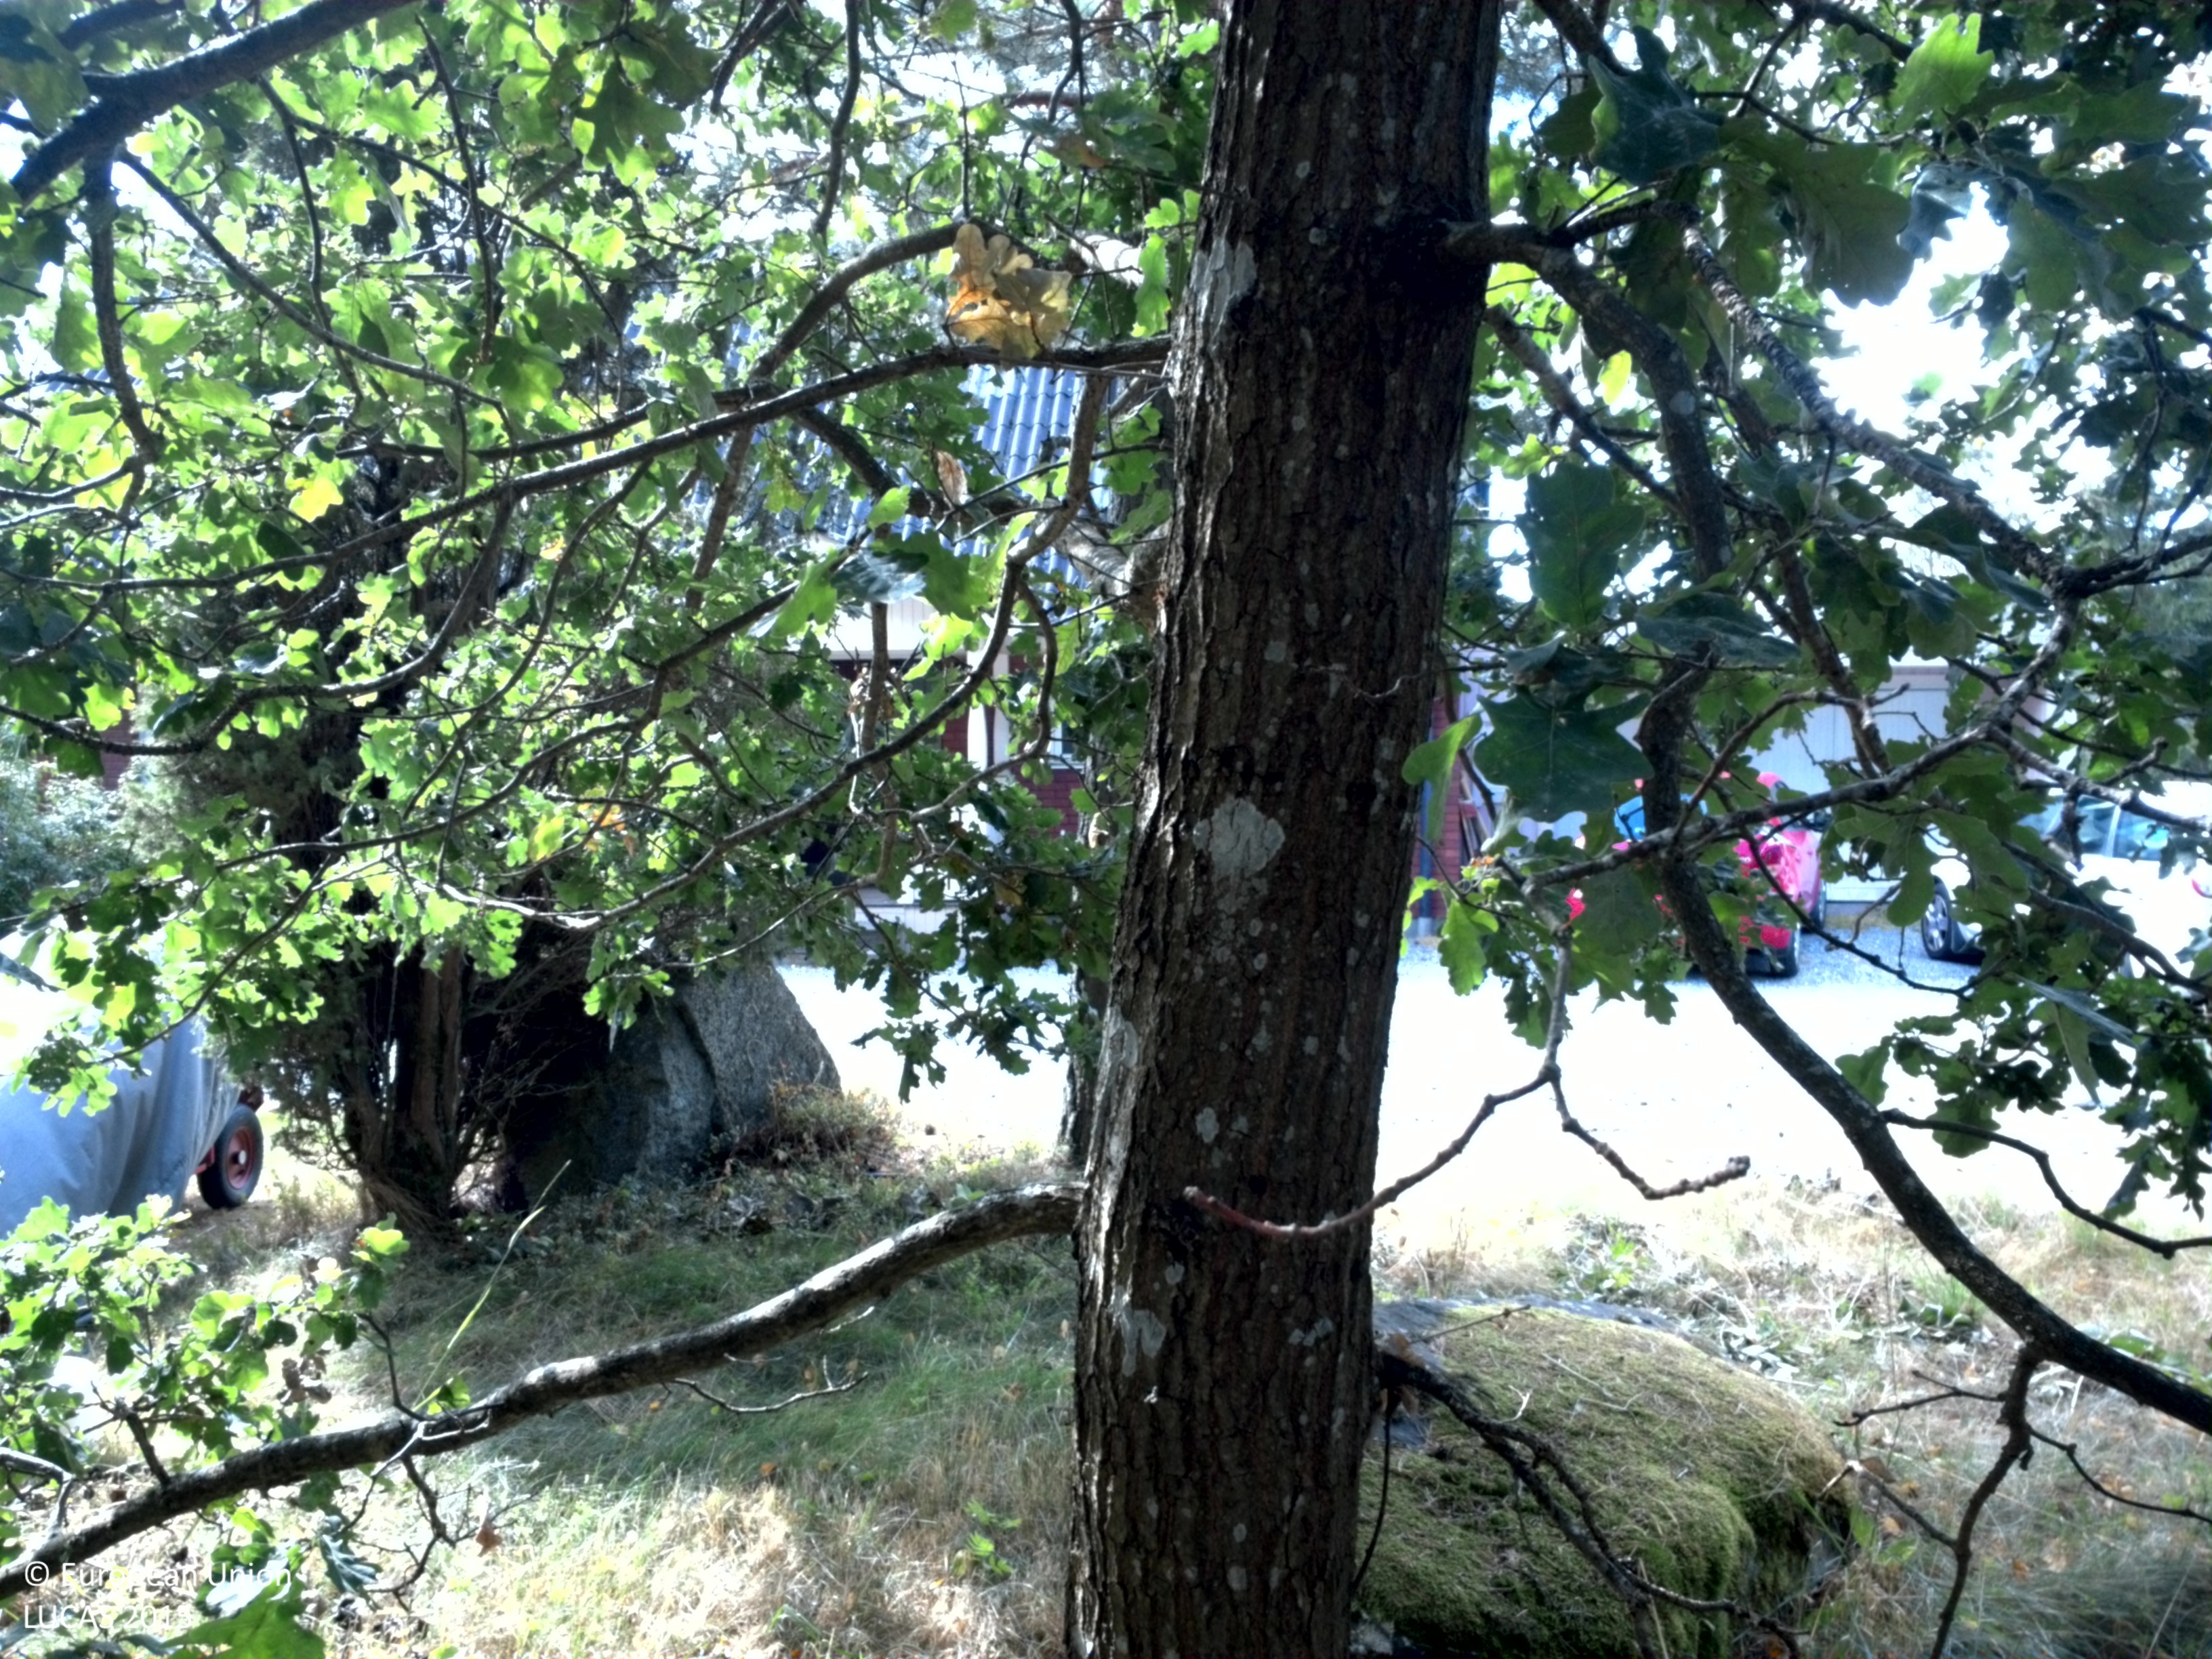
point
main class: Woodland
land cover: Pine dominated mixed woodland
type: boreal forest
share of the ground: 50 - 75 %
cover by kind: coniferous forest trees 50 %, broadleaved forest trees 25 %, herbaceous plants 25 %
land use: Residential
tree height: > 5 m
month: August
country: SE
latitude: 59.6470
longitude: 16.9655
